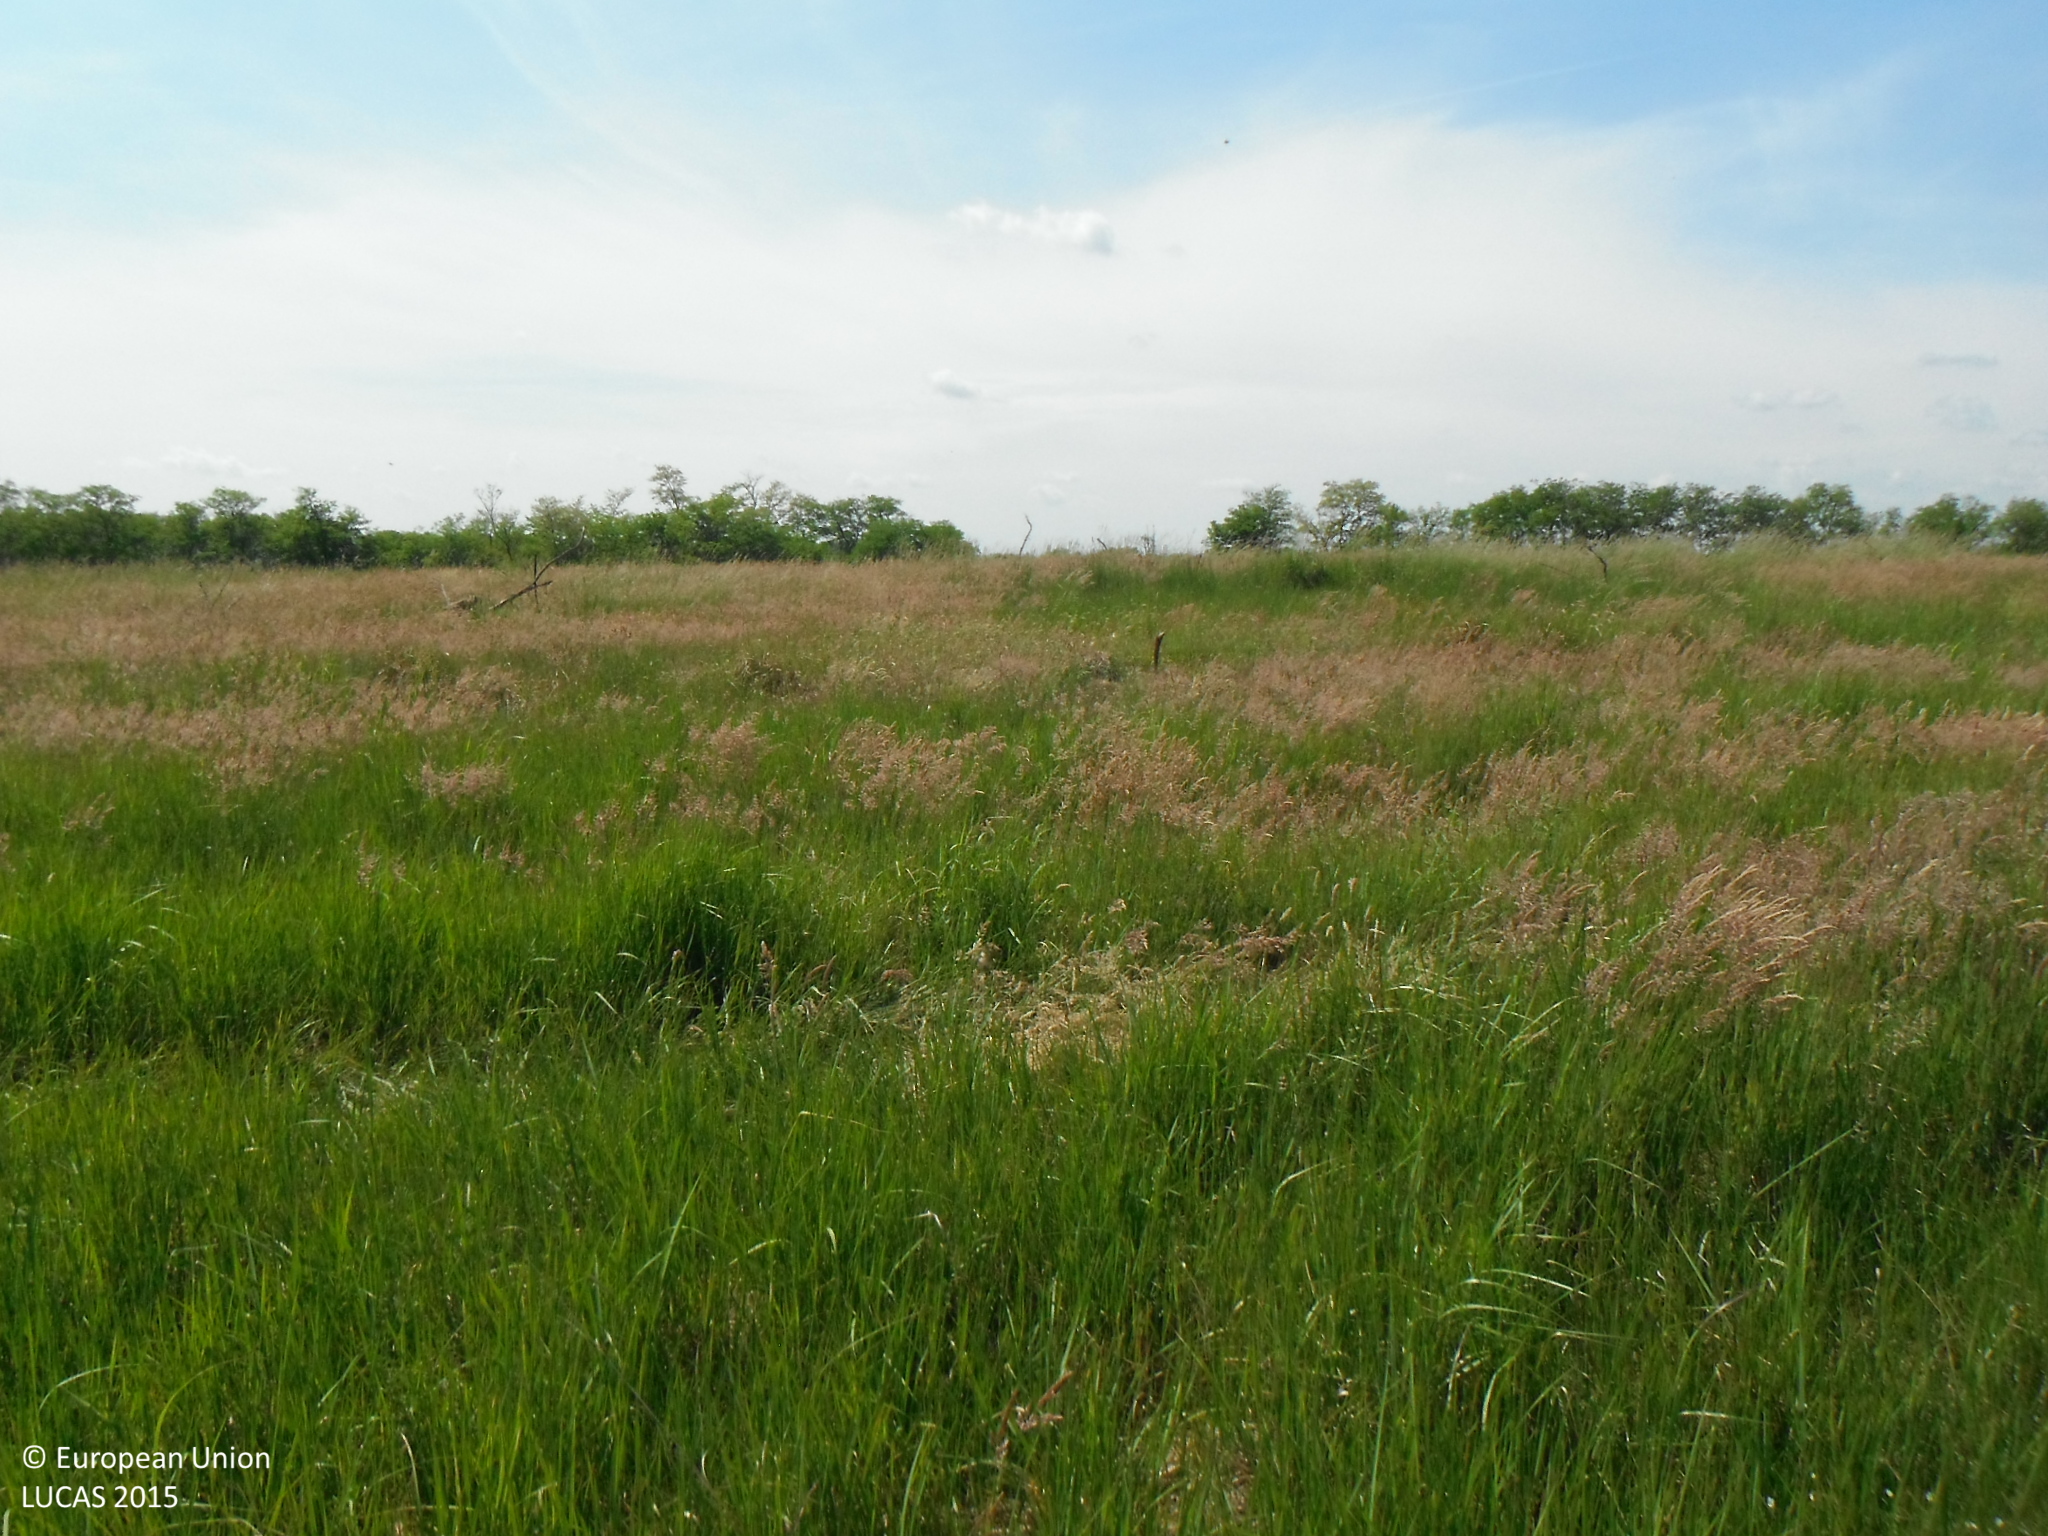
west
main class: Grassland
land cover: Grassland without tree/shrub cover
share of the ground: > 75 %
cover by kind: herbaceous plants 100 %
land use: Agriculture (excluding fallow land and kitchen gardens)
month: June
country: SK
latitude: 48.5940
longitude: 17.0455
